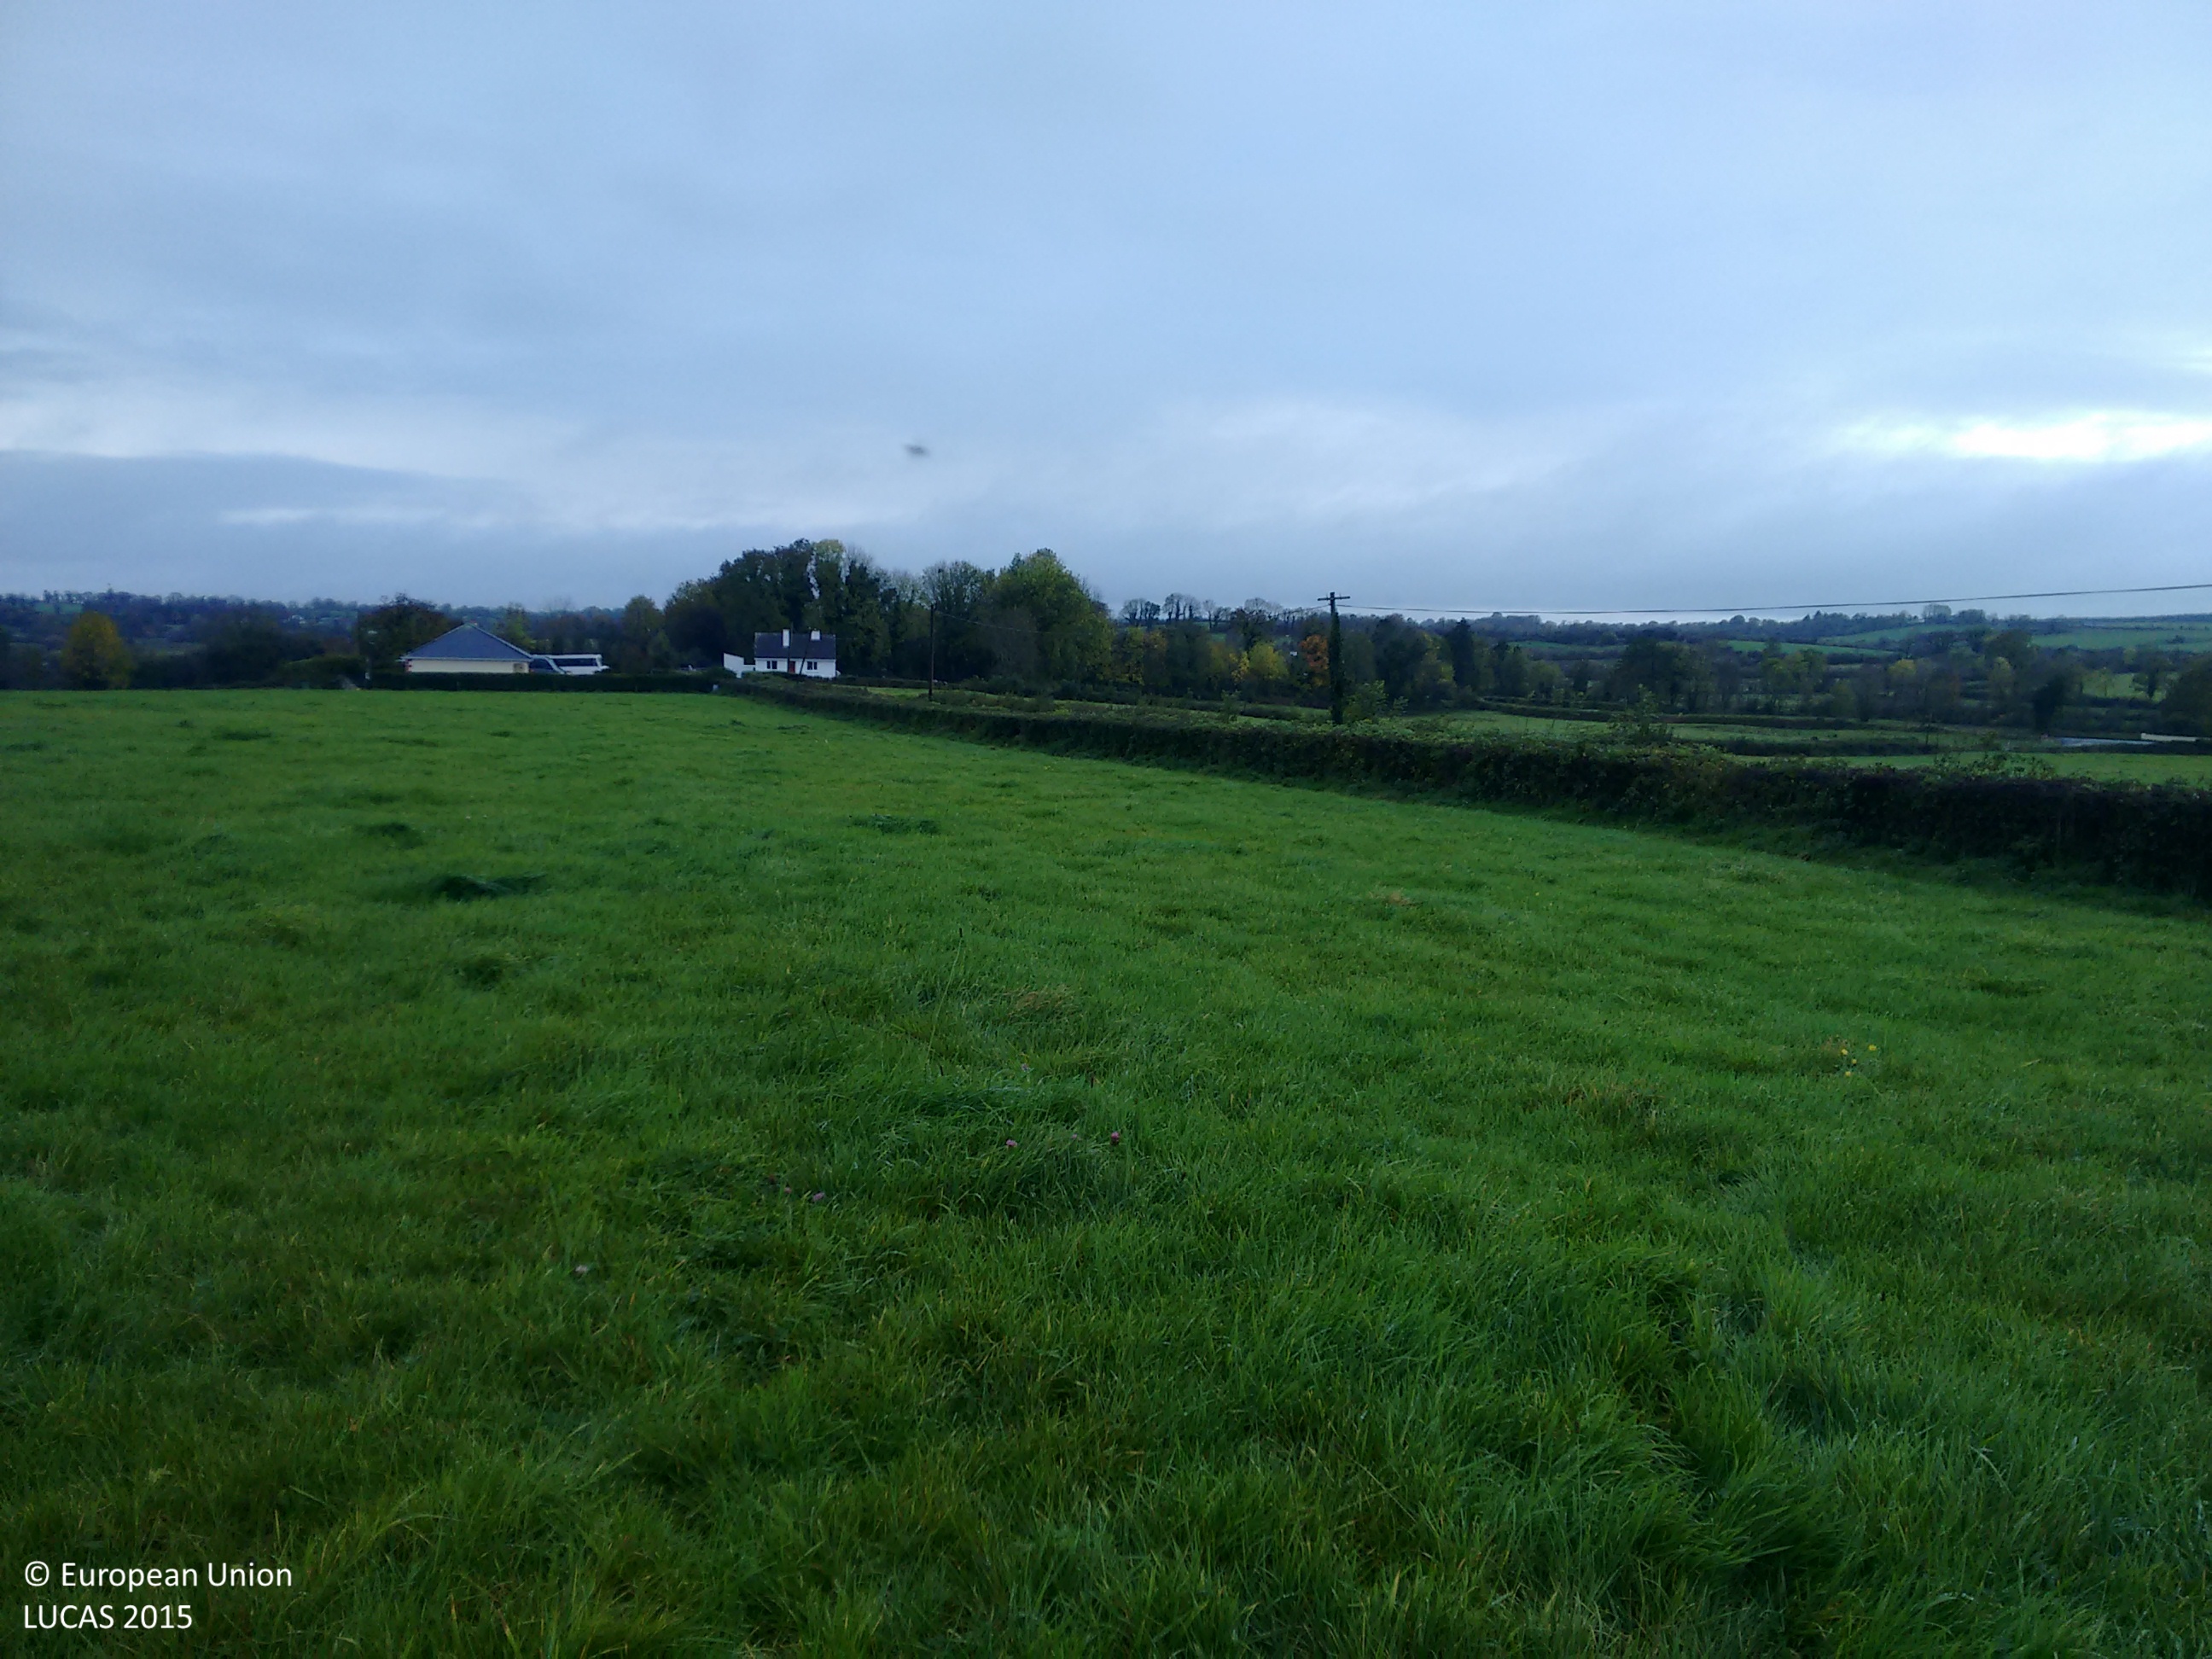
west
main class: Grassland
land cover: Grassland without tree/shrub cover
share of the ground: > 75 %
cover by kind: herbaceous plants 100 %
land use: Agriculture (excluding fallow land and kitchen gardens)
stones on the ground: < 10 %
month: October
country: IE
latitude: 53.8615
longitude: -8.1367
